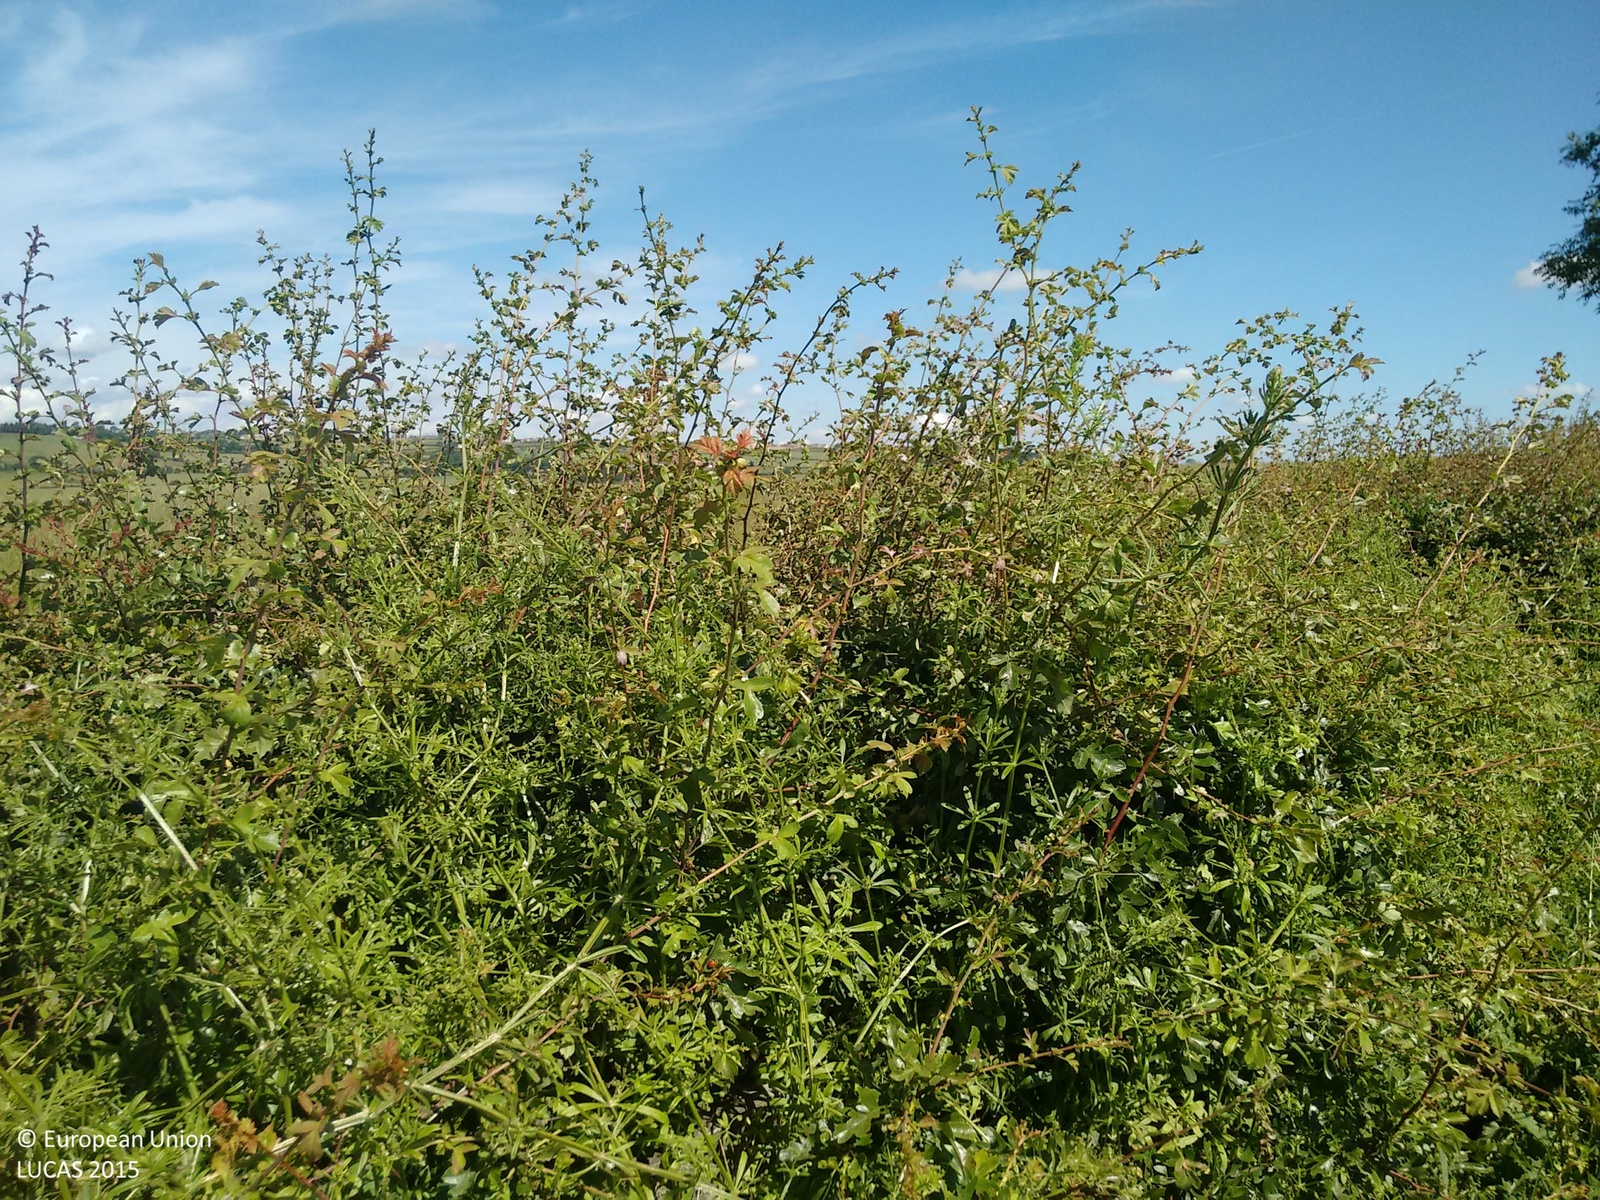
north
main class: Grassland
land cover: Grassland without tree/shrub cover
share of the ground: > 75 %
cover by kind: herbaceous plants 100 %
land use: Agriculture (excluding fallow land and kitchen gardens)
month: July
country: GB
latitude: 54.6277
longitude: -1.7464
